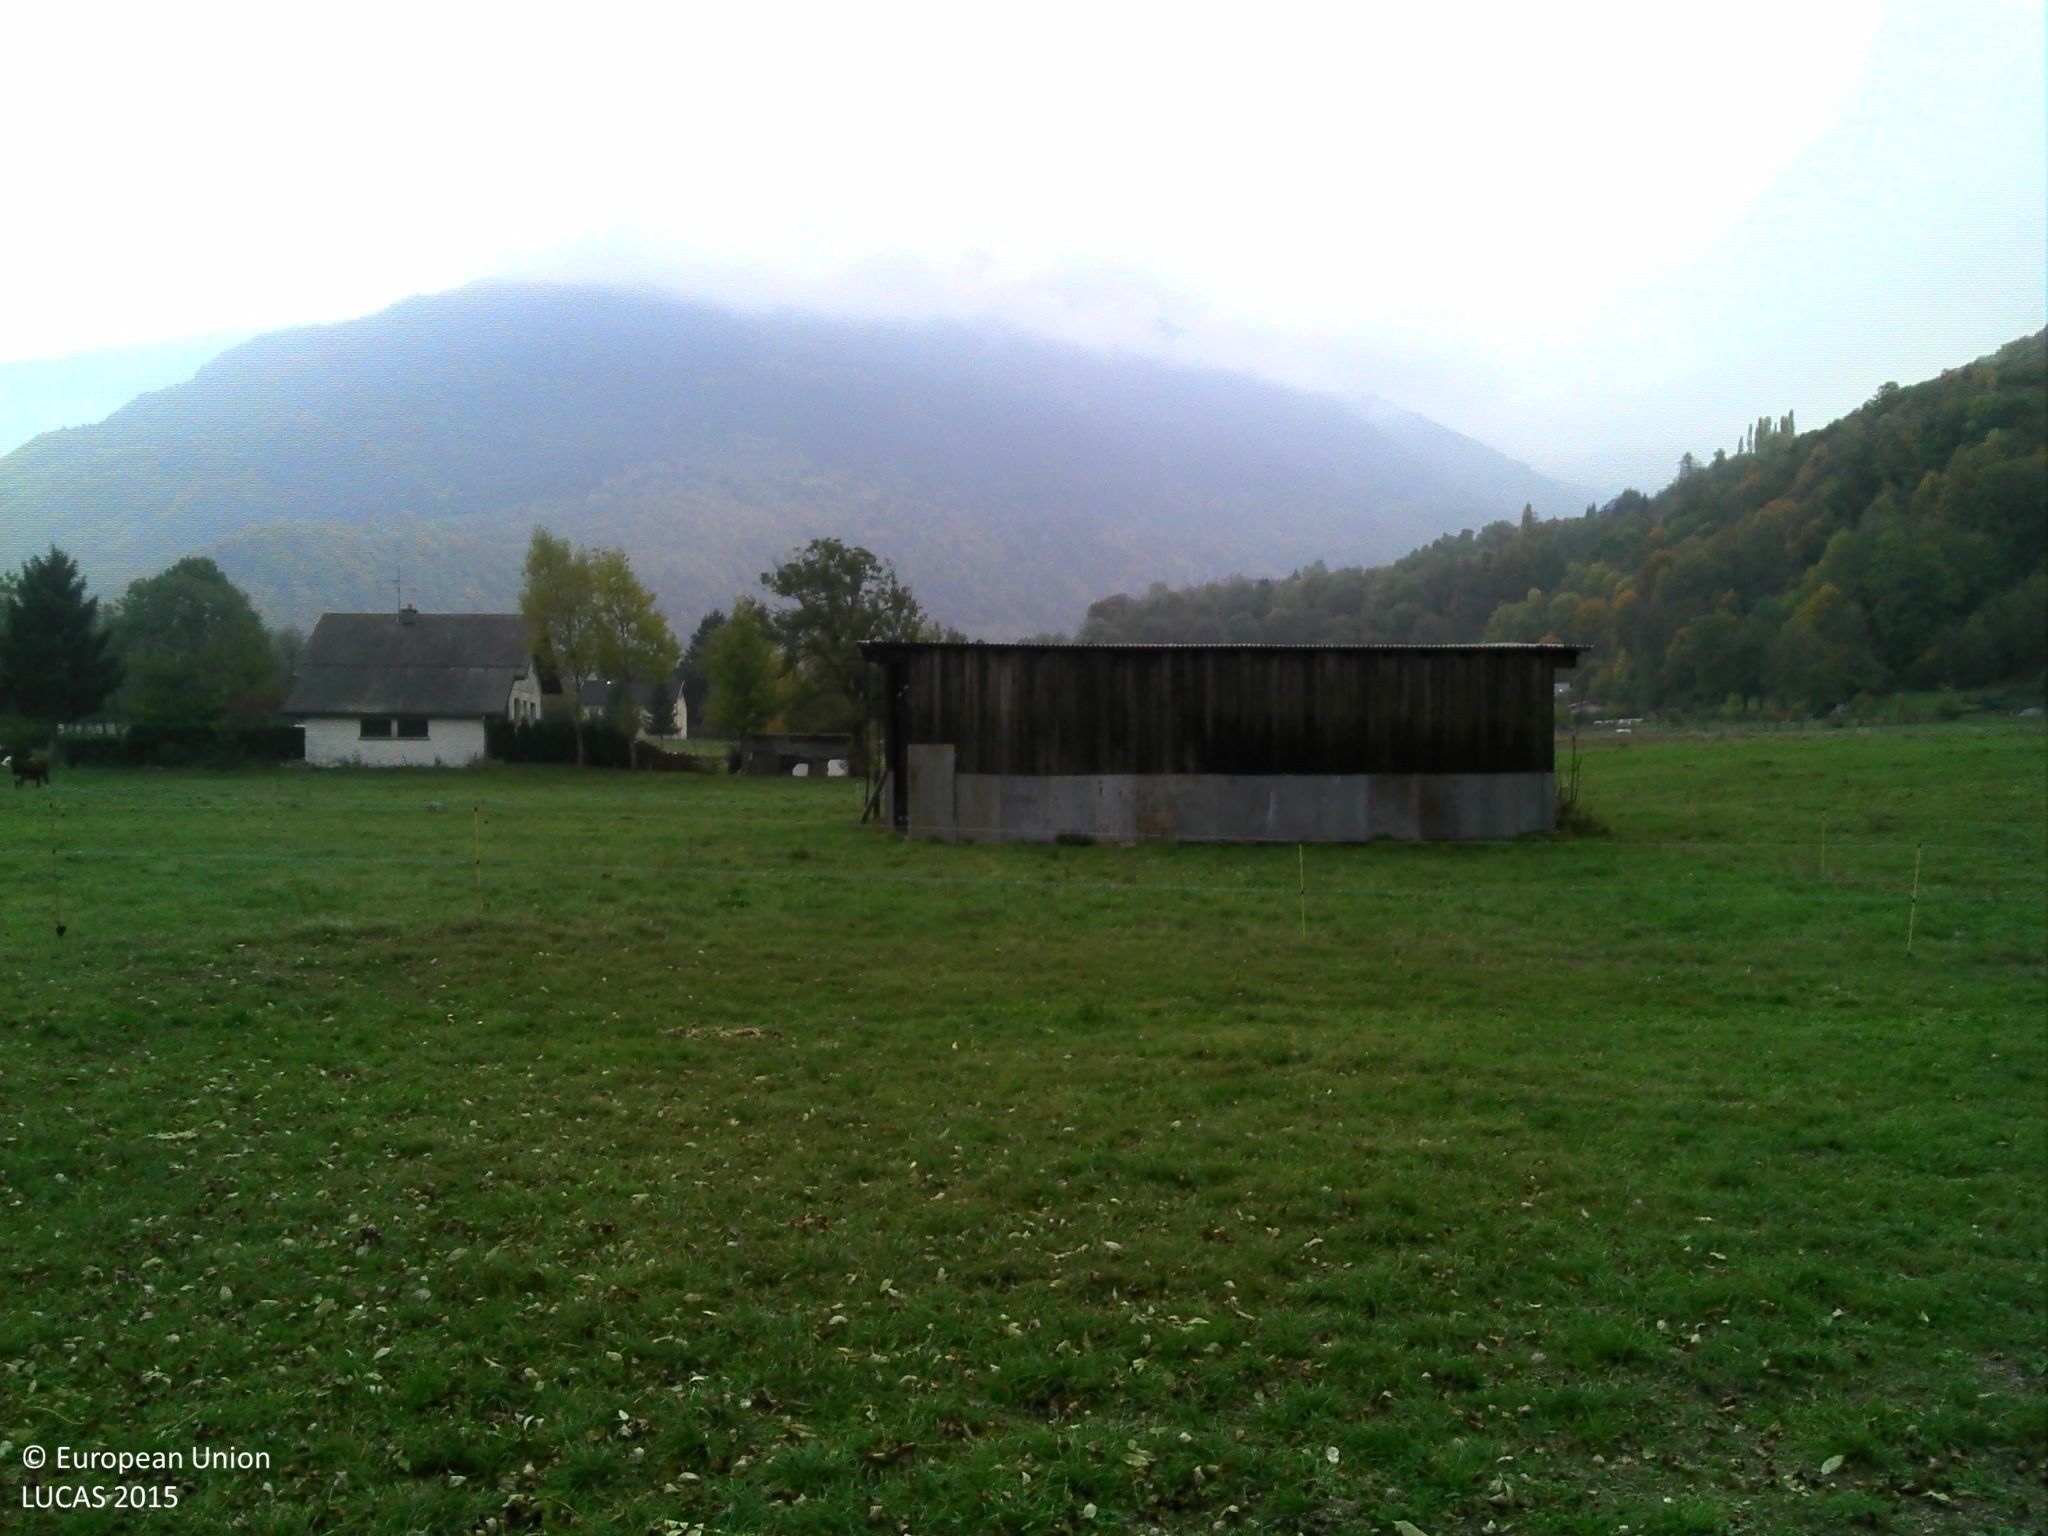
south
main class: Grassland
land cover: Grassland with sparse tree/shrub cover
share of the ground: > 75 %
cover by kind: herbaceous plants 90 %, broadleaved forest trees 5 %, consolidated bare surface 5 %
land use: Agriculture (excluding fallow land and kitchen gardens)
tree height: > 5 m
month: October
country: FR
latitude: 45.3491
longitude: 6.2907
